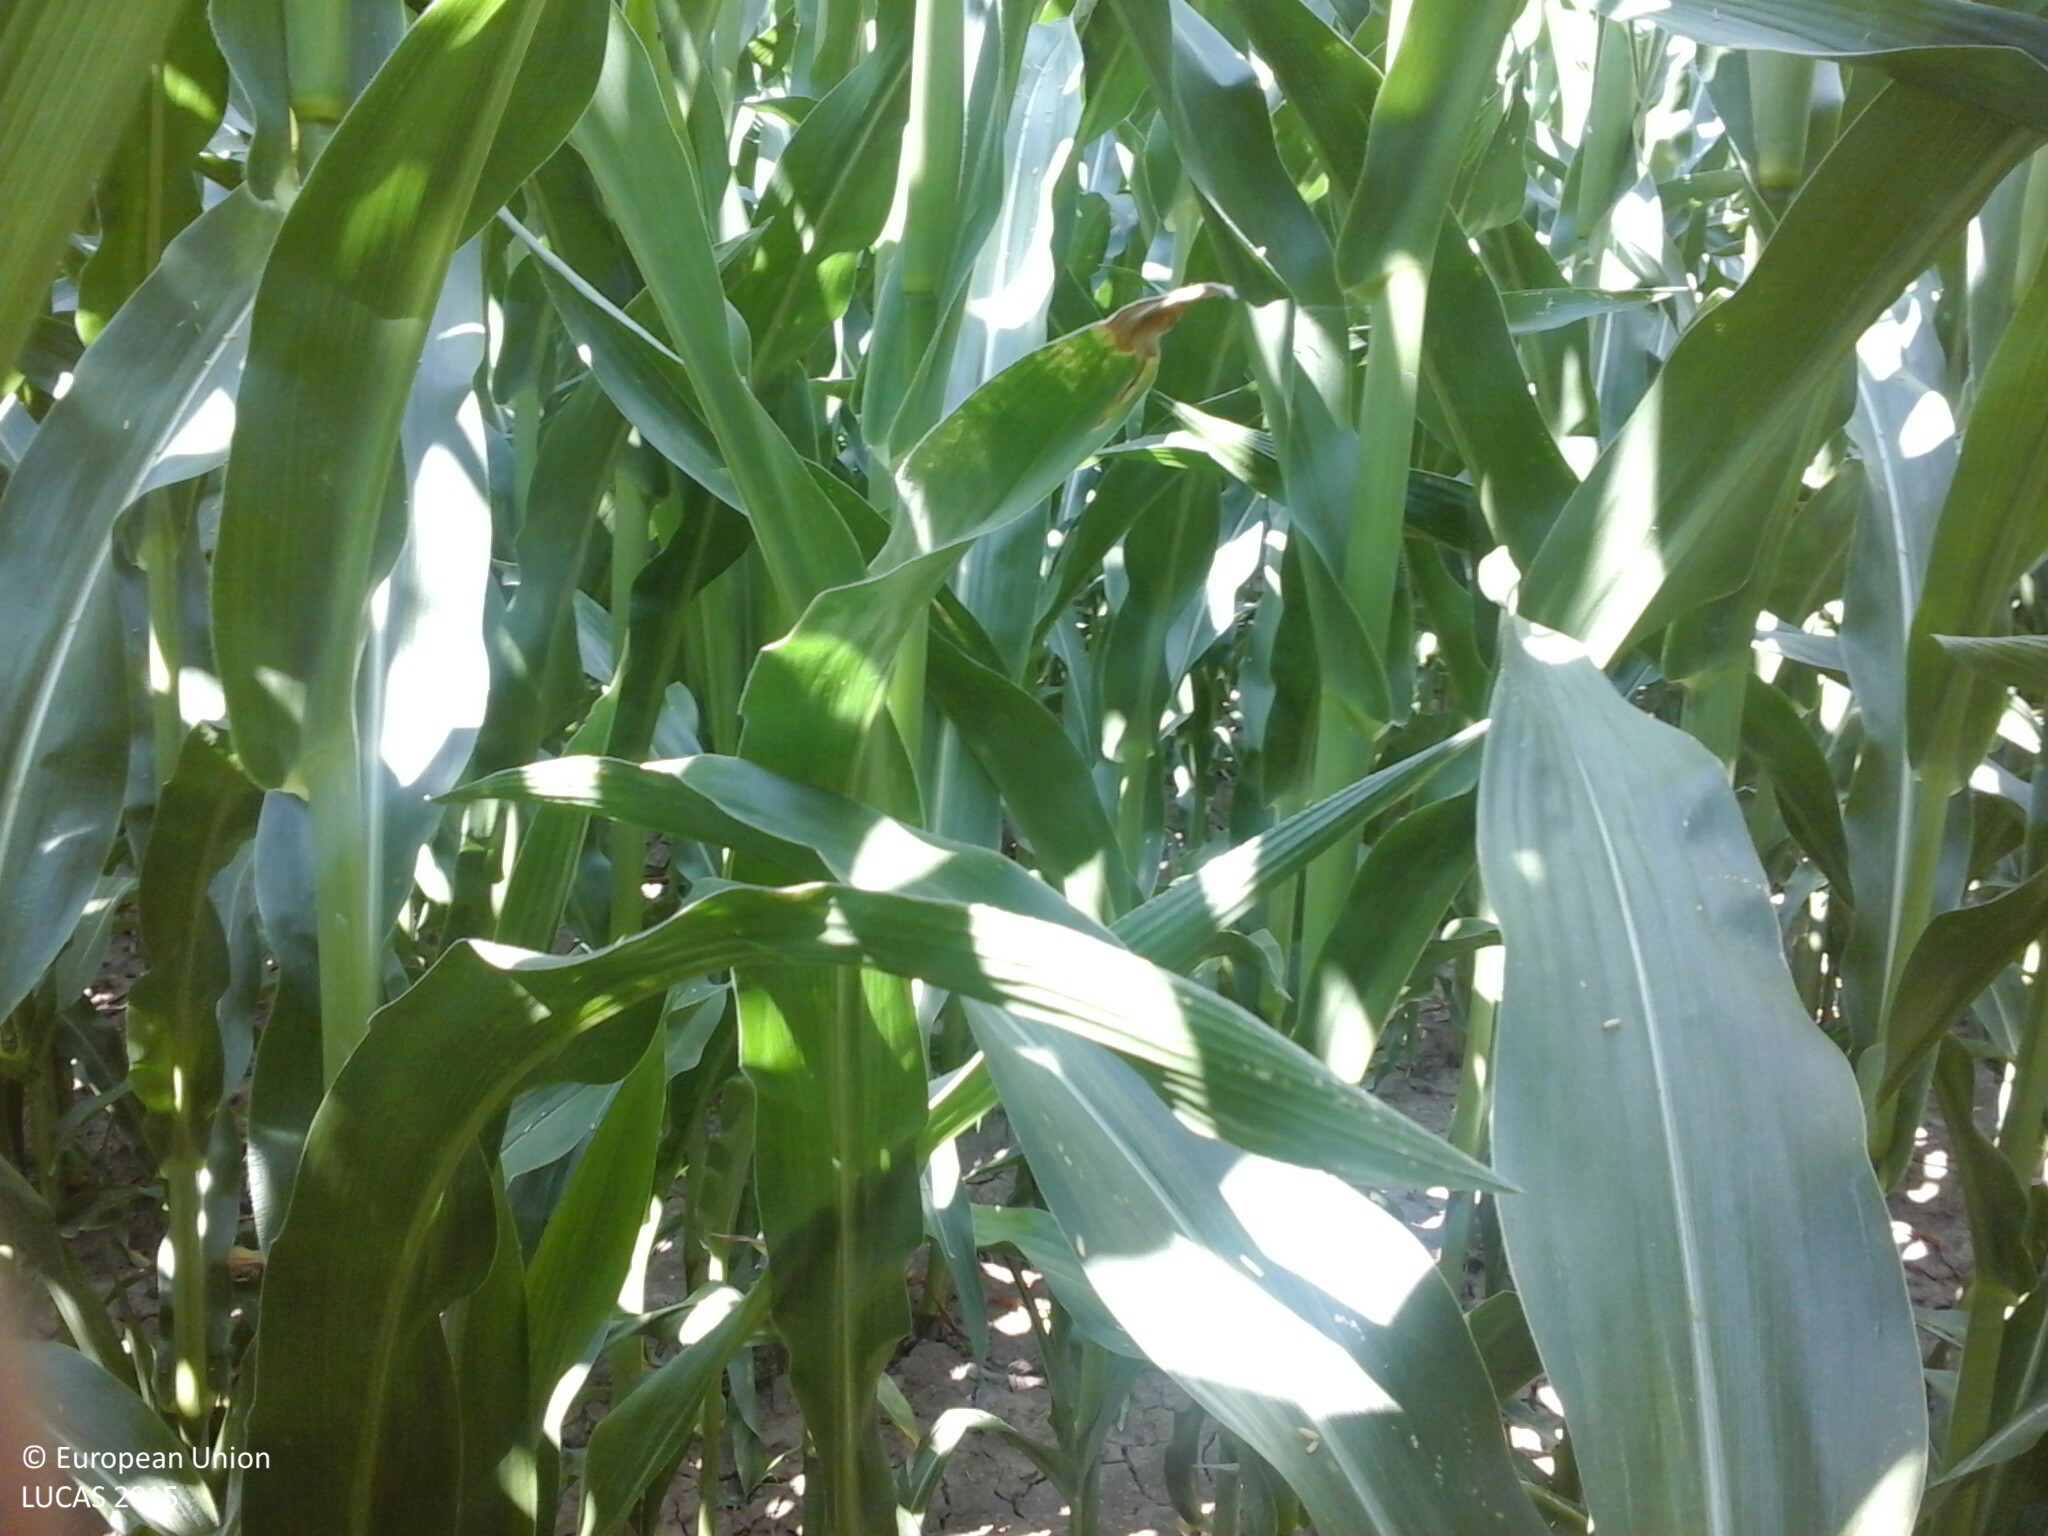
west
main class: Cropland
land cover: Maize
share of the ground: > 75 %
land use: Agriculture (excluding fallow land and kitchen gardens)
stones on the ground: < 10 %
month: July
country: HU
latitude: 48.1058
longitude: 22.3734
